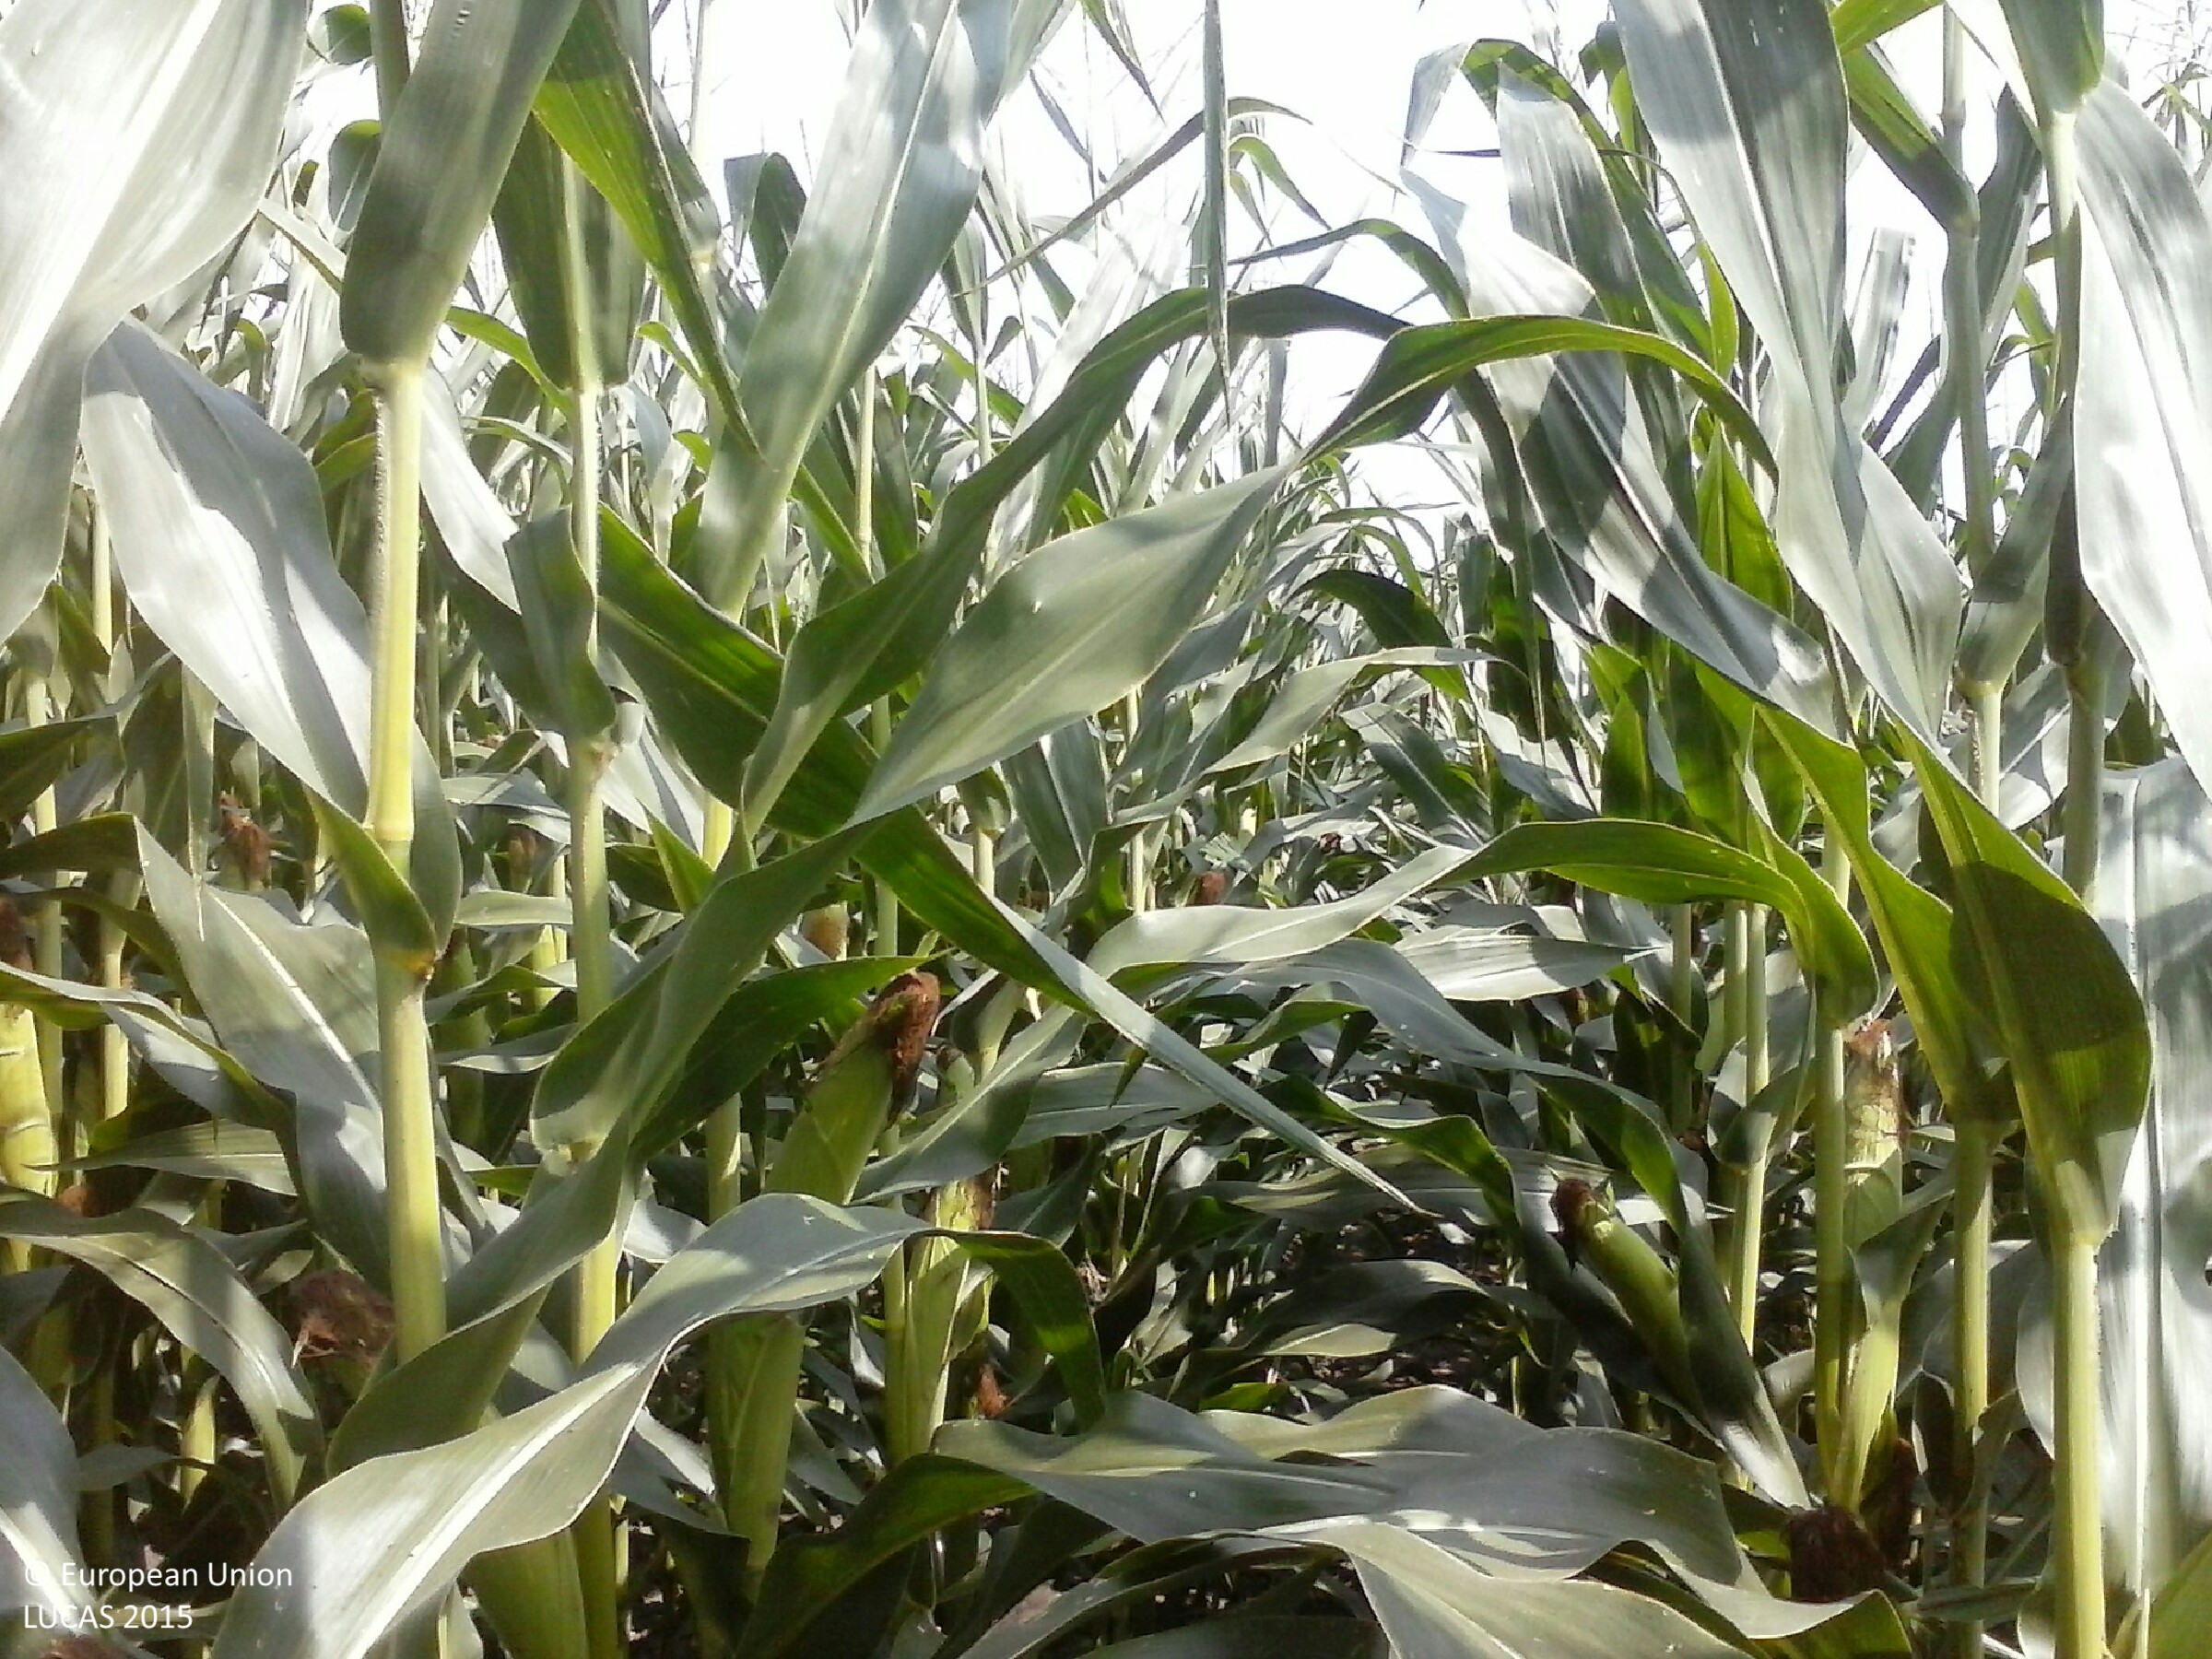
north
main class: Cropland
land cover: Maize
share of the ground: > 75 %
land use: Agriculture (excluding fallow land and kitchen gardens)
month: July
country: HU
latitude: 46.7236
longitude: 20.1115
